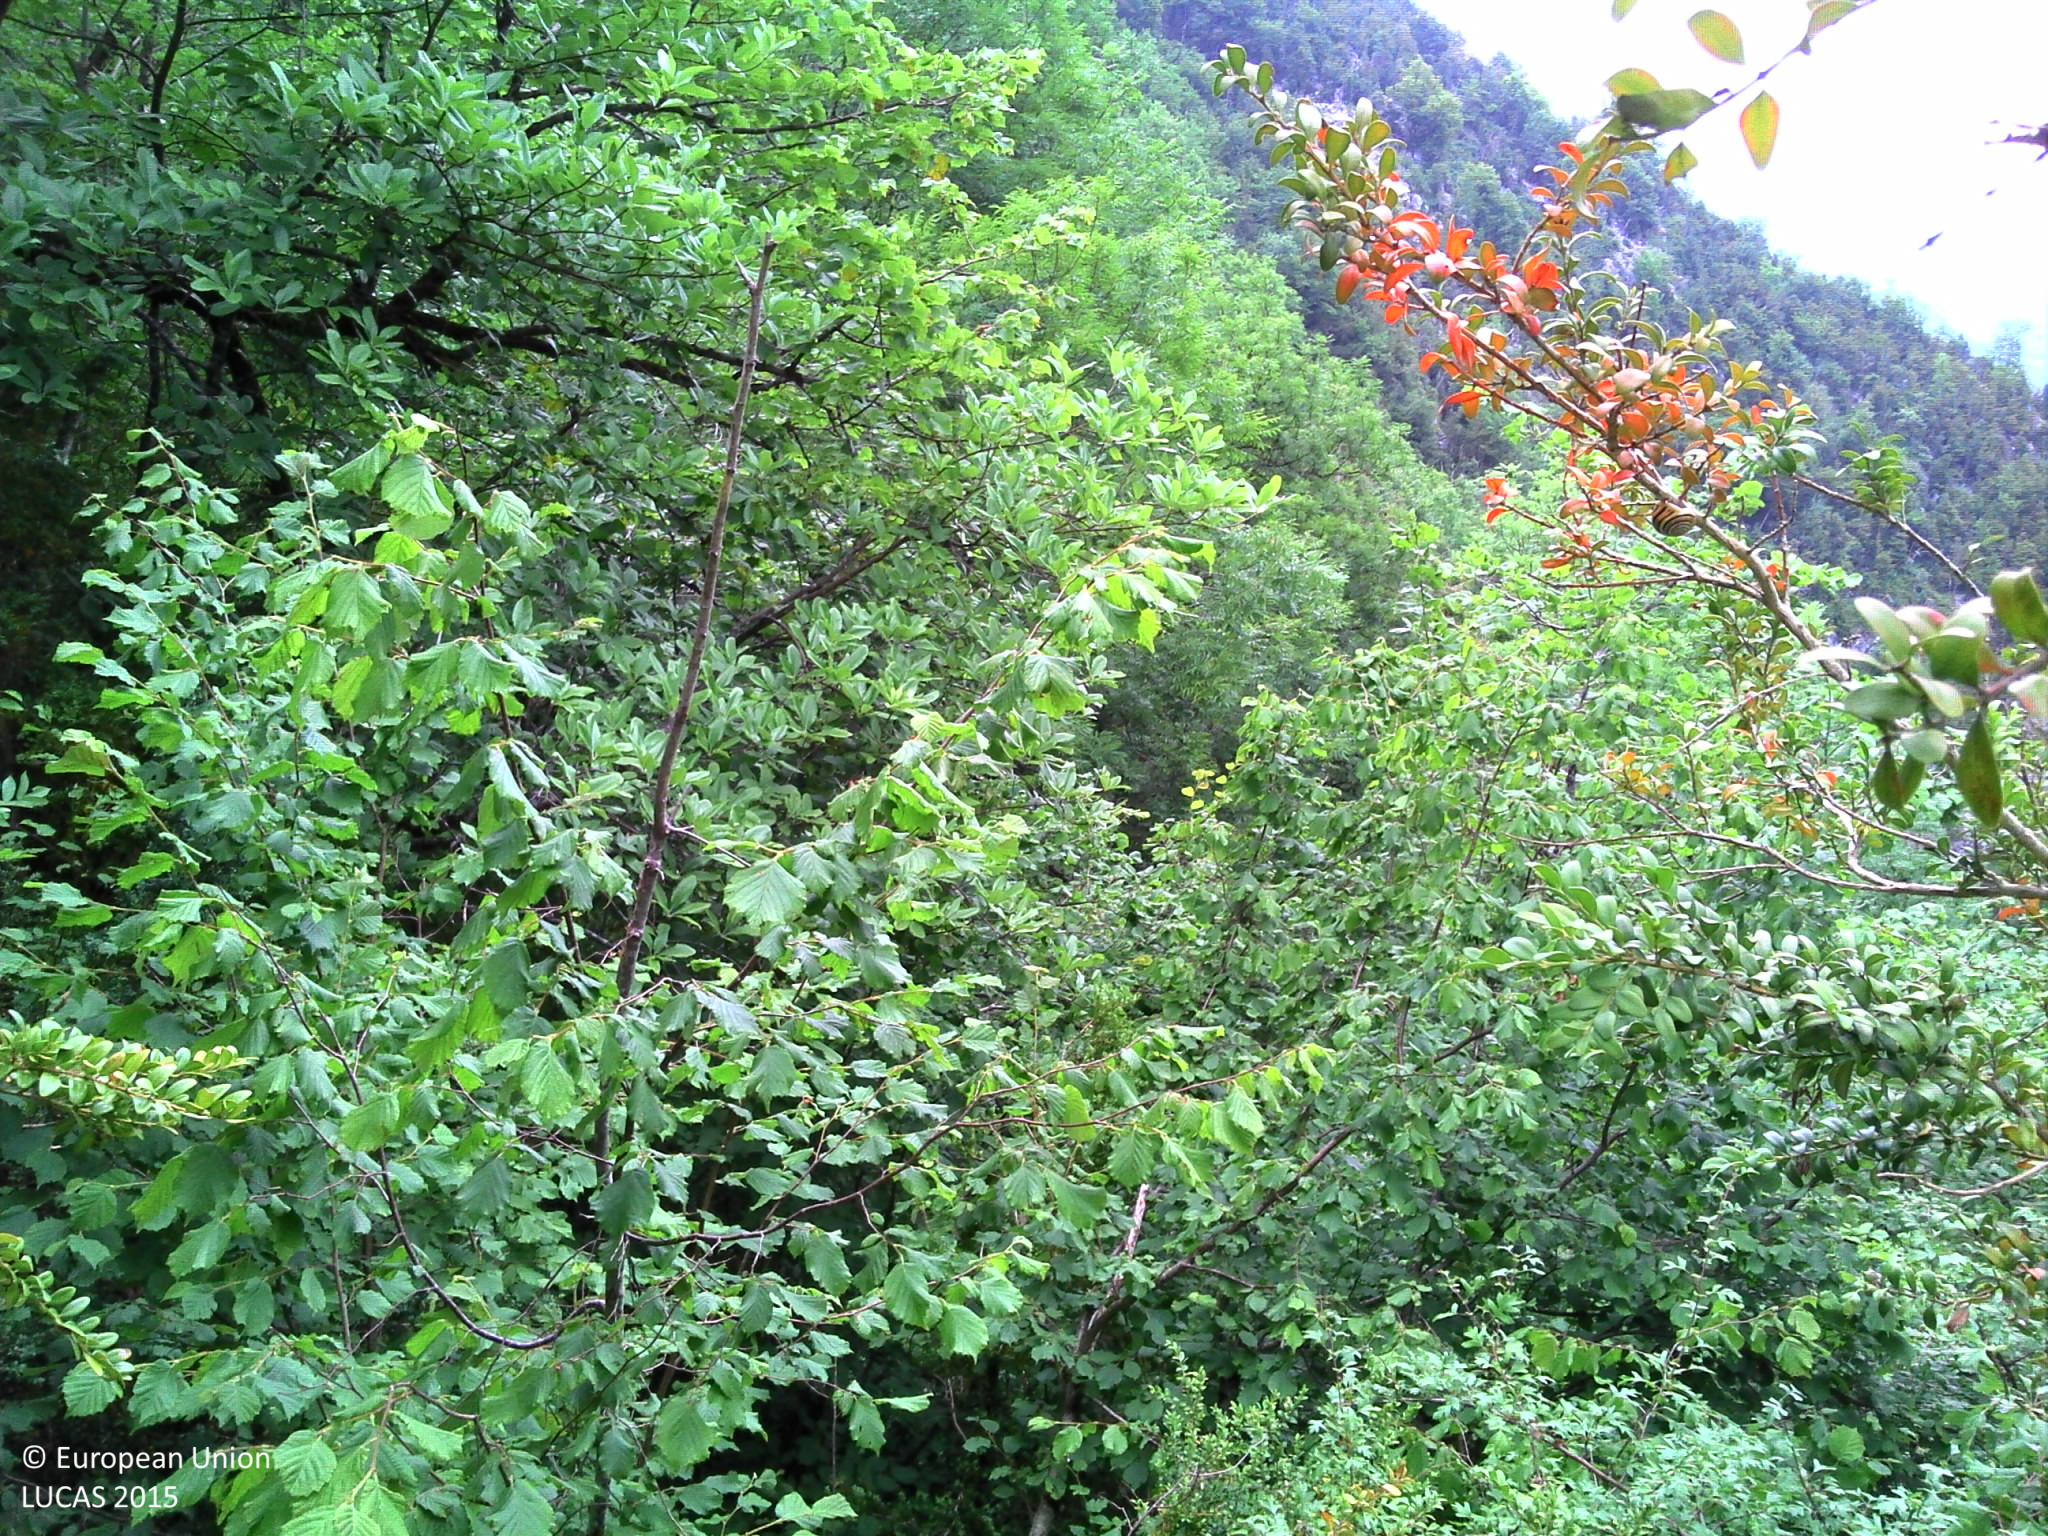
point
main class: Woodland
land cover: Broadleaved woodland
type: mountainous beech forest
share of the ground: > 75 %
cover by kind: broadleaved forest trees 50 %, shrubs 30 %, herbaceous plants 10 %, consolidated bare surface 10 %
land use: Semi-natural and natural areas not in use
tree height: > 5 m
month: July
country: FR
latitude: 42.9249
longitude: 0.8023
